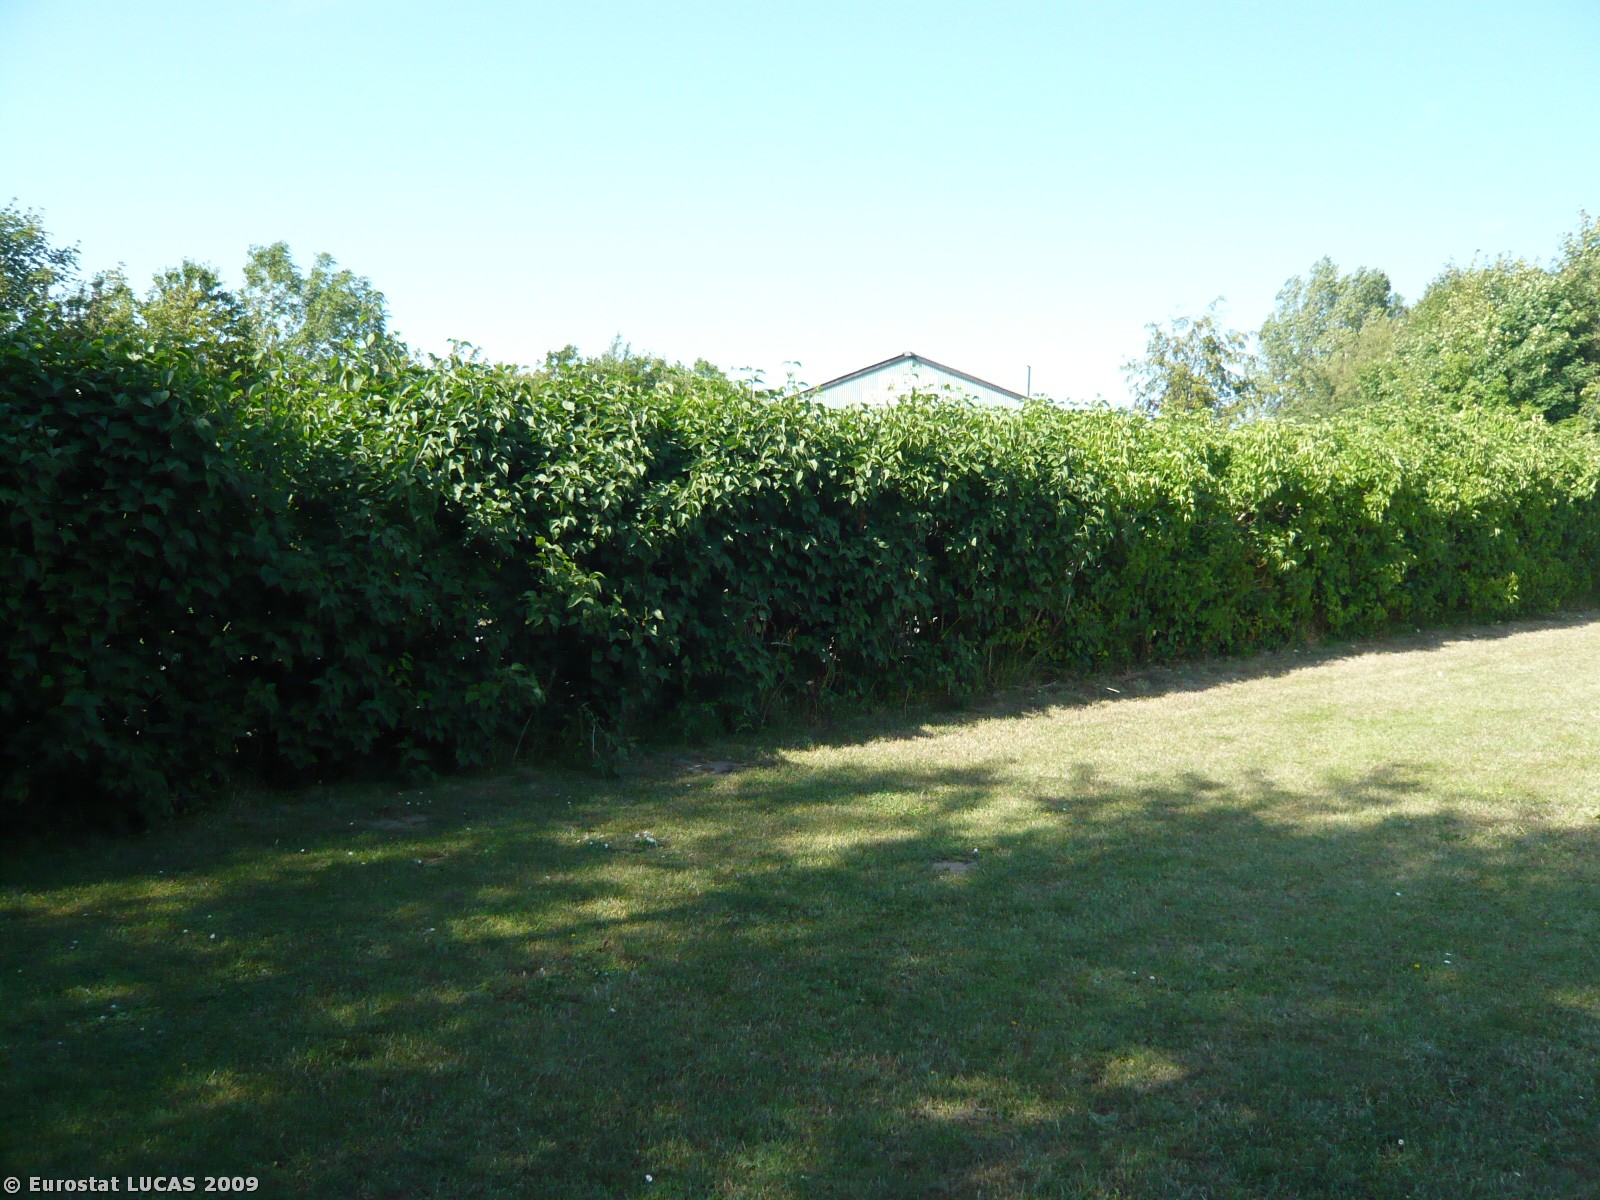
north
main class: Grassland
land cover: Grassland without tree/shrub cover
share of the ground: > 75 %
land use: Residential
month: July
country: DK
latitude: 55.7462
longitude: 11.6074
